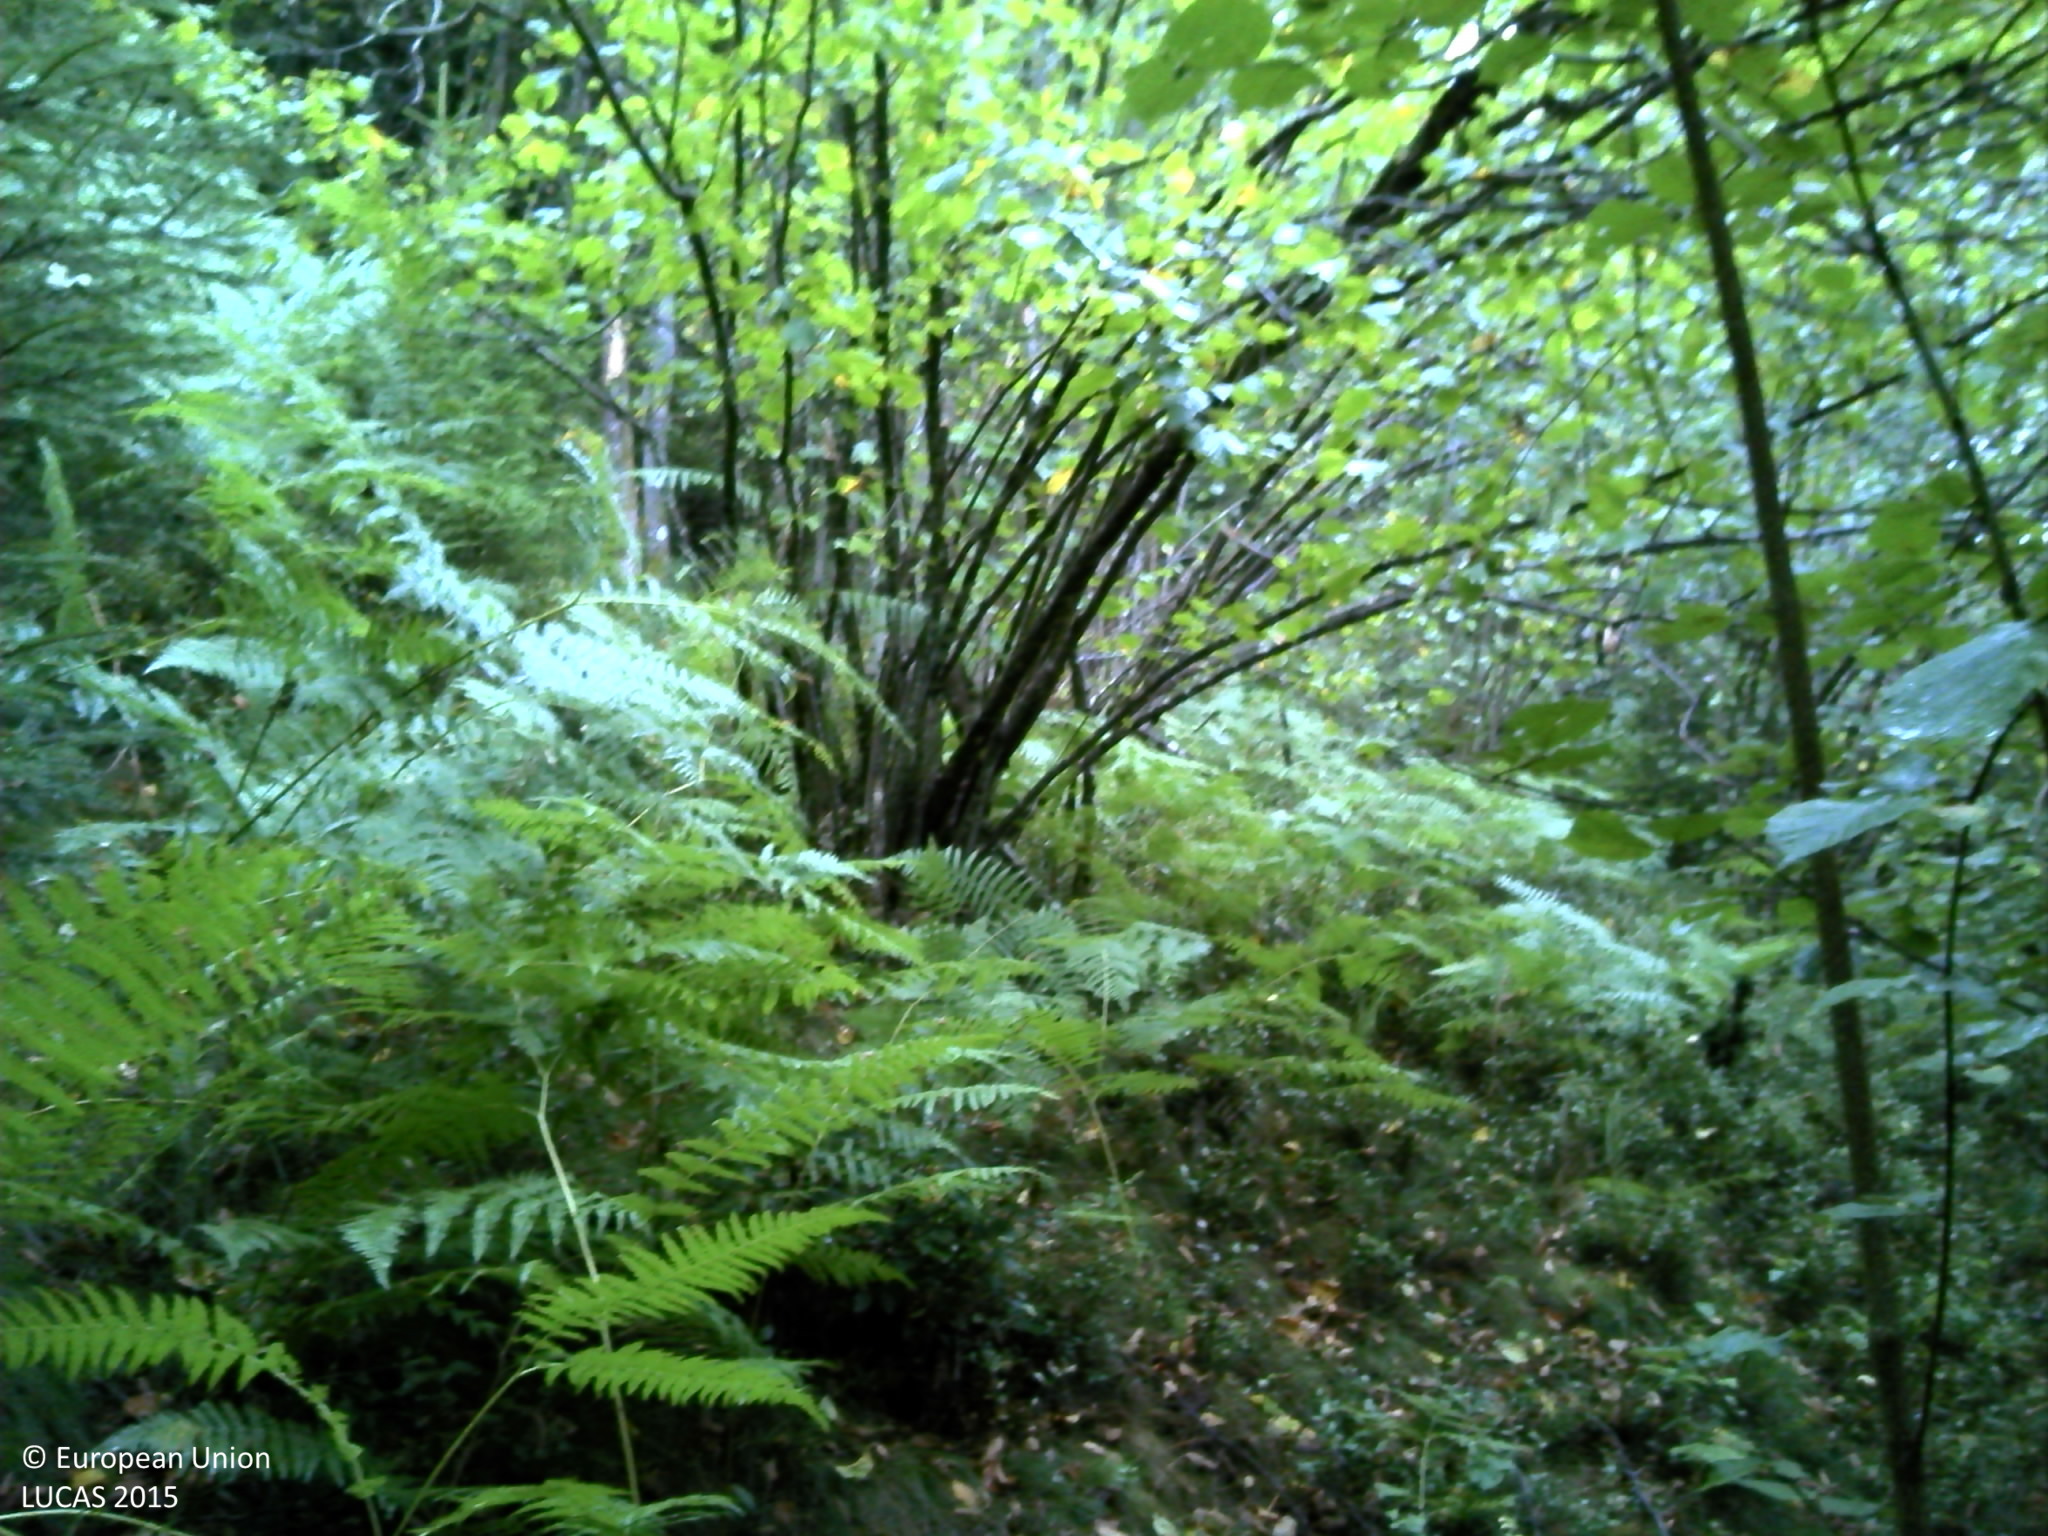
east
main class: Woodland
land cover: Spruce dominated mixed woodland
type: mountainous beech forest
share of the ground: > 75 %
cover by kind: broadleaved forest trees 50 %, coniferous forest trees 40 %, herbaceous plants 5 %, unconsolidated bare surface 5 %
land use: Forestry
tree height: > 5 m
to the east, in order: Spruce dominated mixed woodland; Shrubland with sparse tree cover; Dry stone walls; Shrubland with sparse tree cover; Tracks; Shrubland with sparse tree cover; Tracks; Spruce dominated mixed woodland
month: August
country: FR
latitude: 47.9446
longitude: 6.8549
